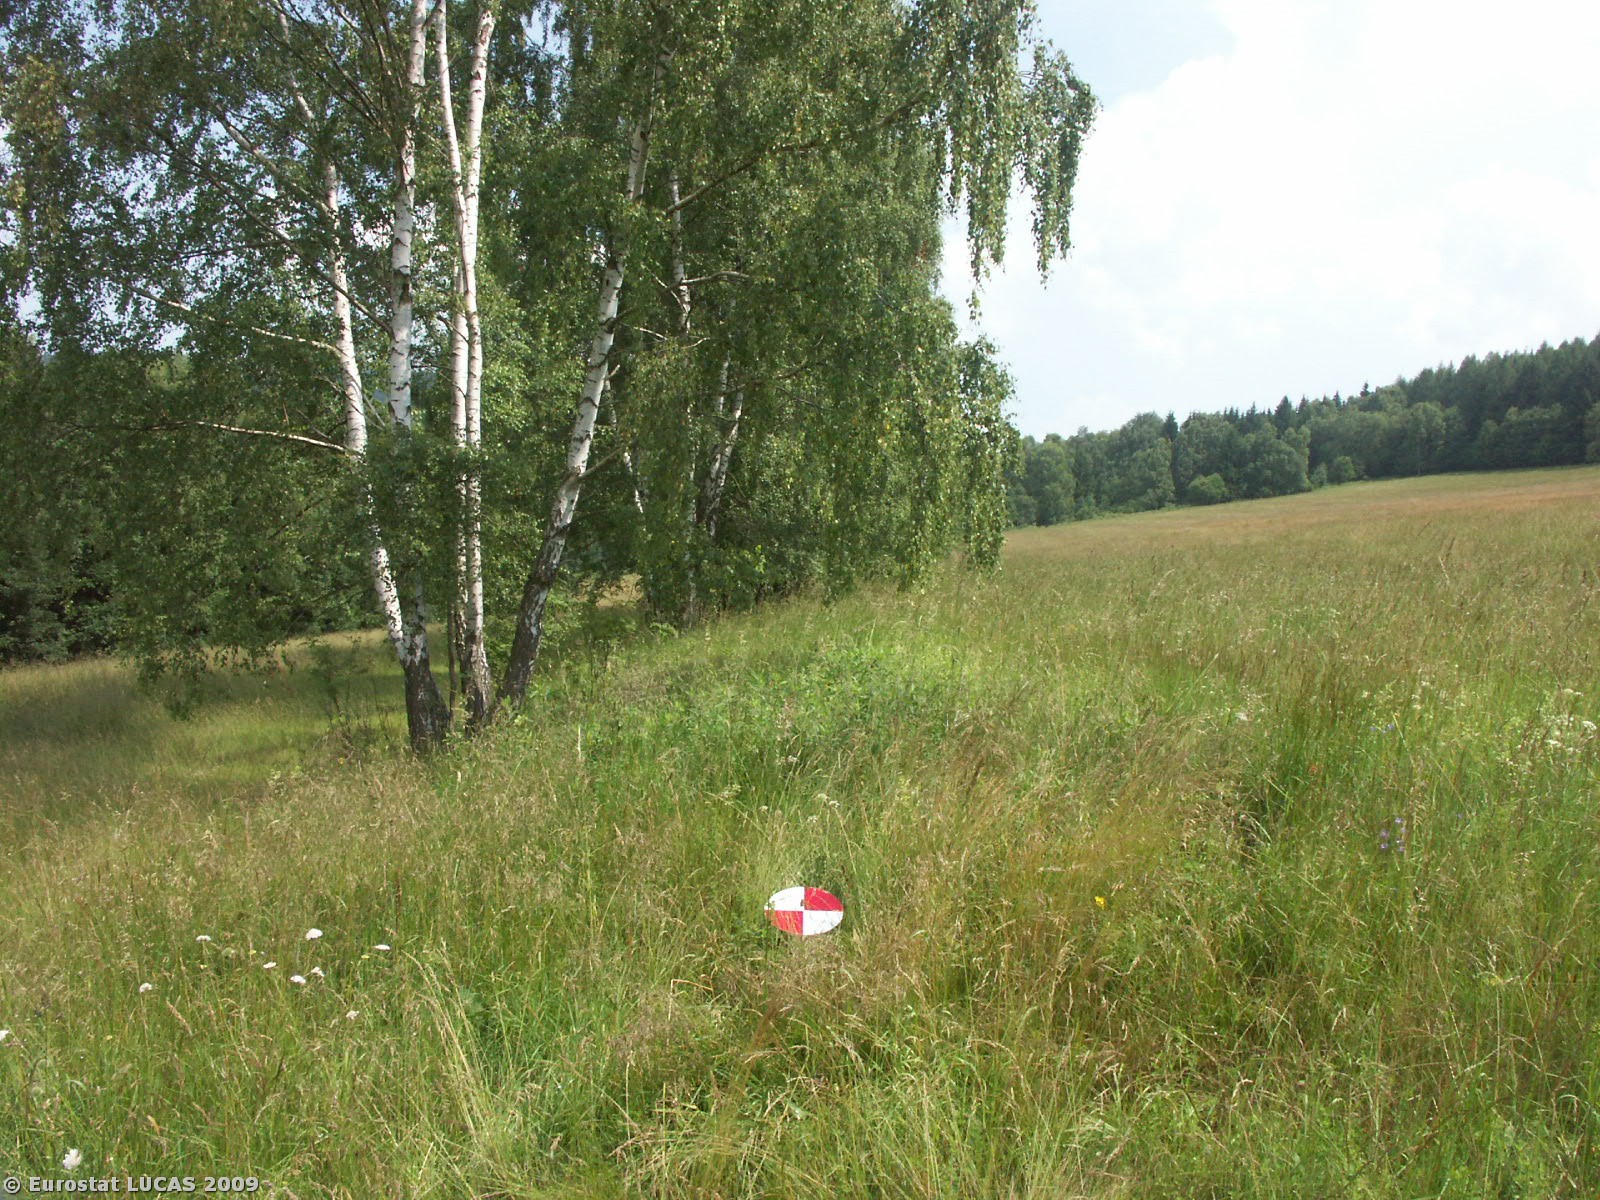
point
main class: Grassland
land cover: Grassland without tree/shrub cover
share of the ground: > 75 %
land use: Agriculture (excluding fallow land and kitchen gardens)
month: July
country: CZ
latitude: 50.0252
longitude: 16.6664
